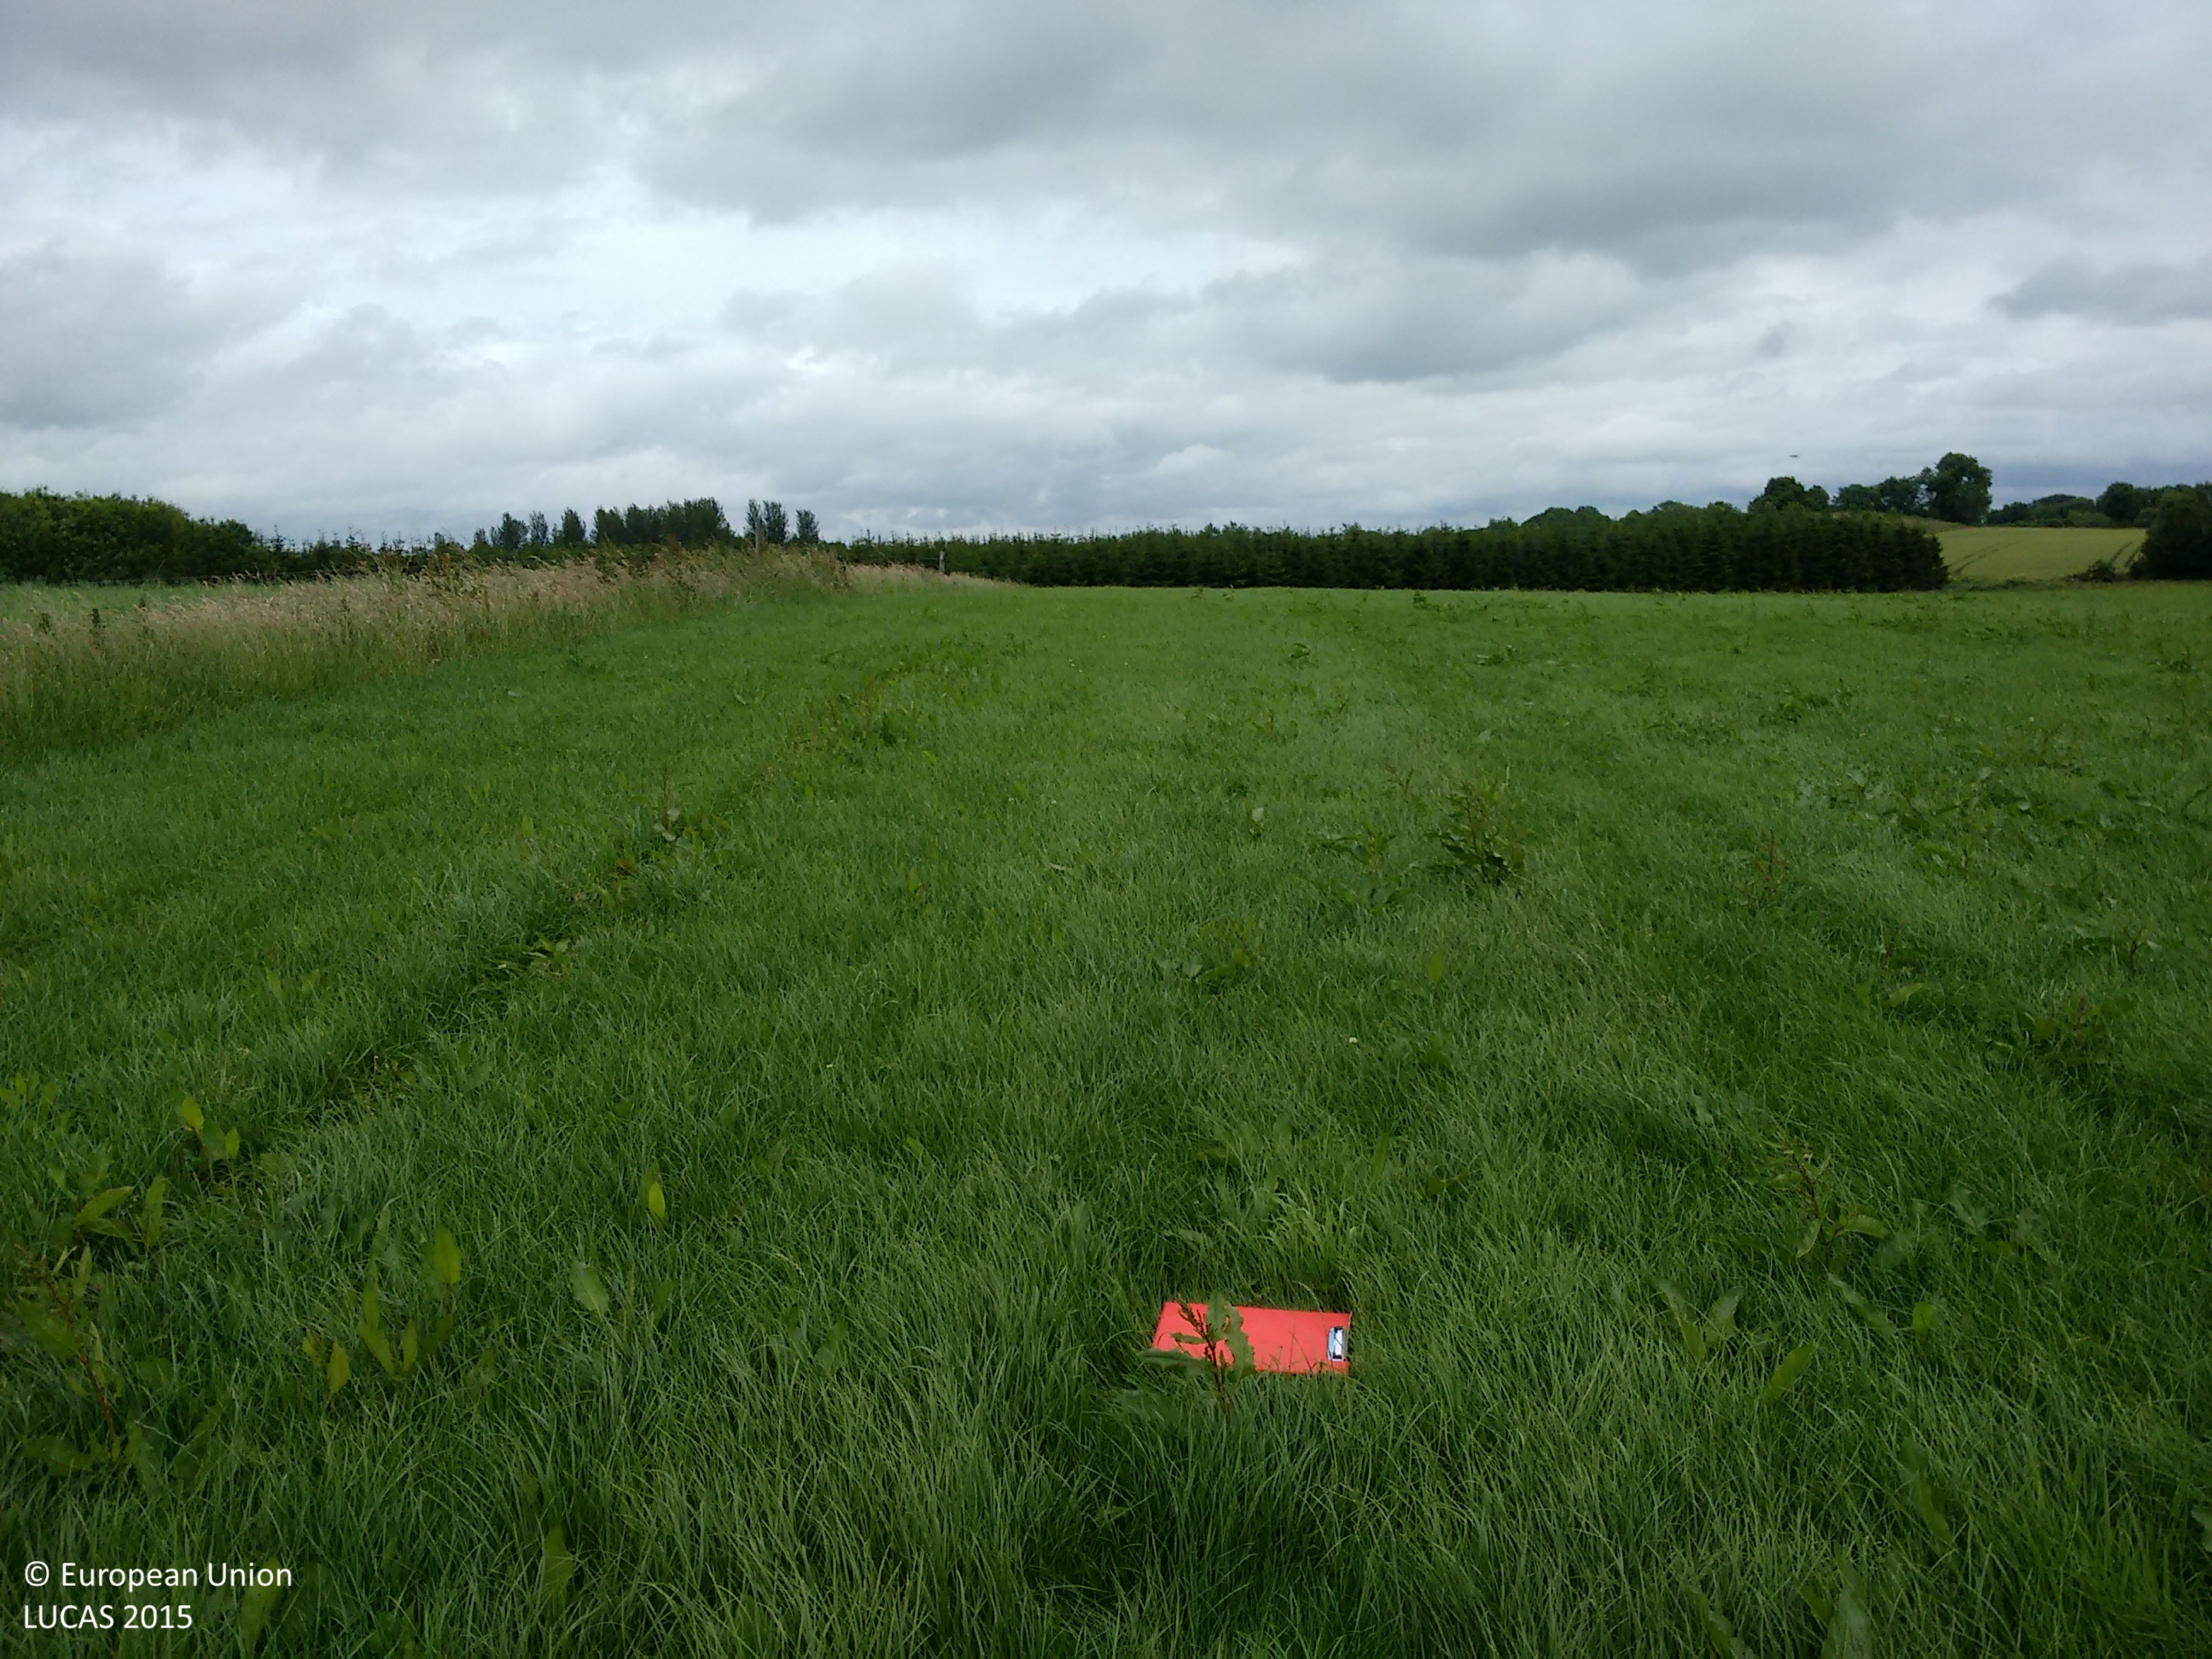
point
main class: Grassland
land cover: Grassland without tree/shrub cover
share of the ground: > 75 %
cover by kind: herbaceous plants 100 %
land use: Agriculture (excluding fallow land and kitchen gardens)
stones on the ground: < 10 %
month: July
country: IE
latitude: 53.5966
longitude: -7.0512
